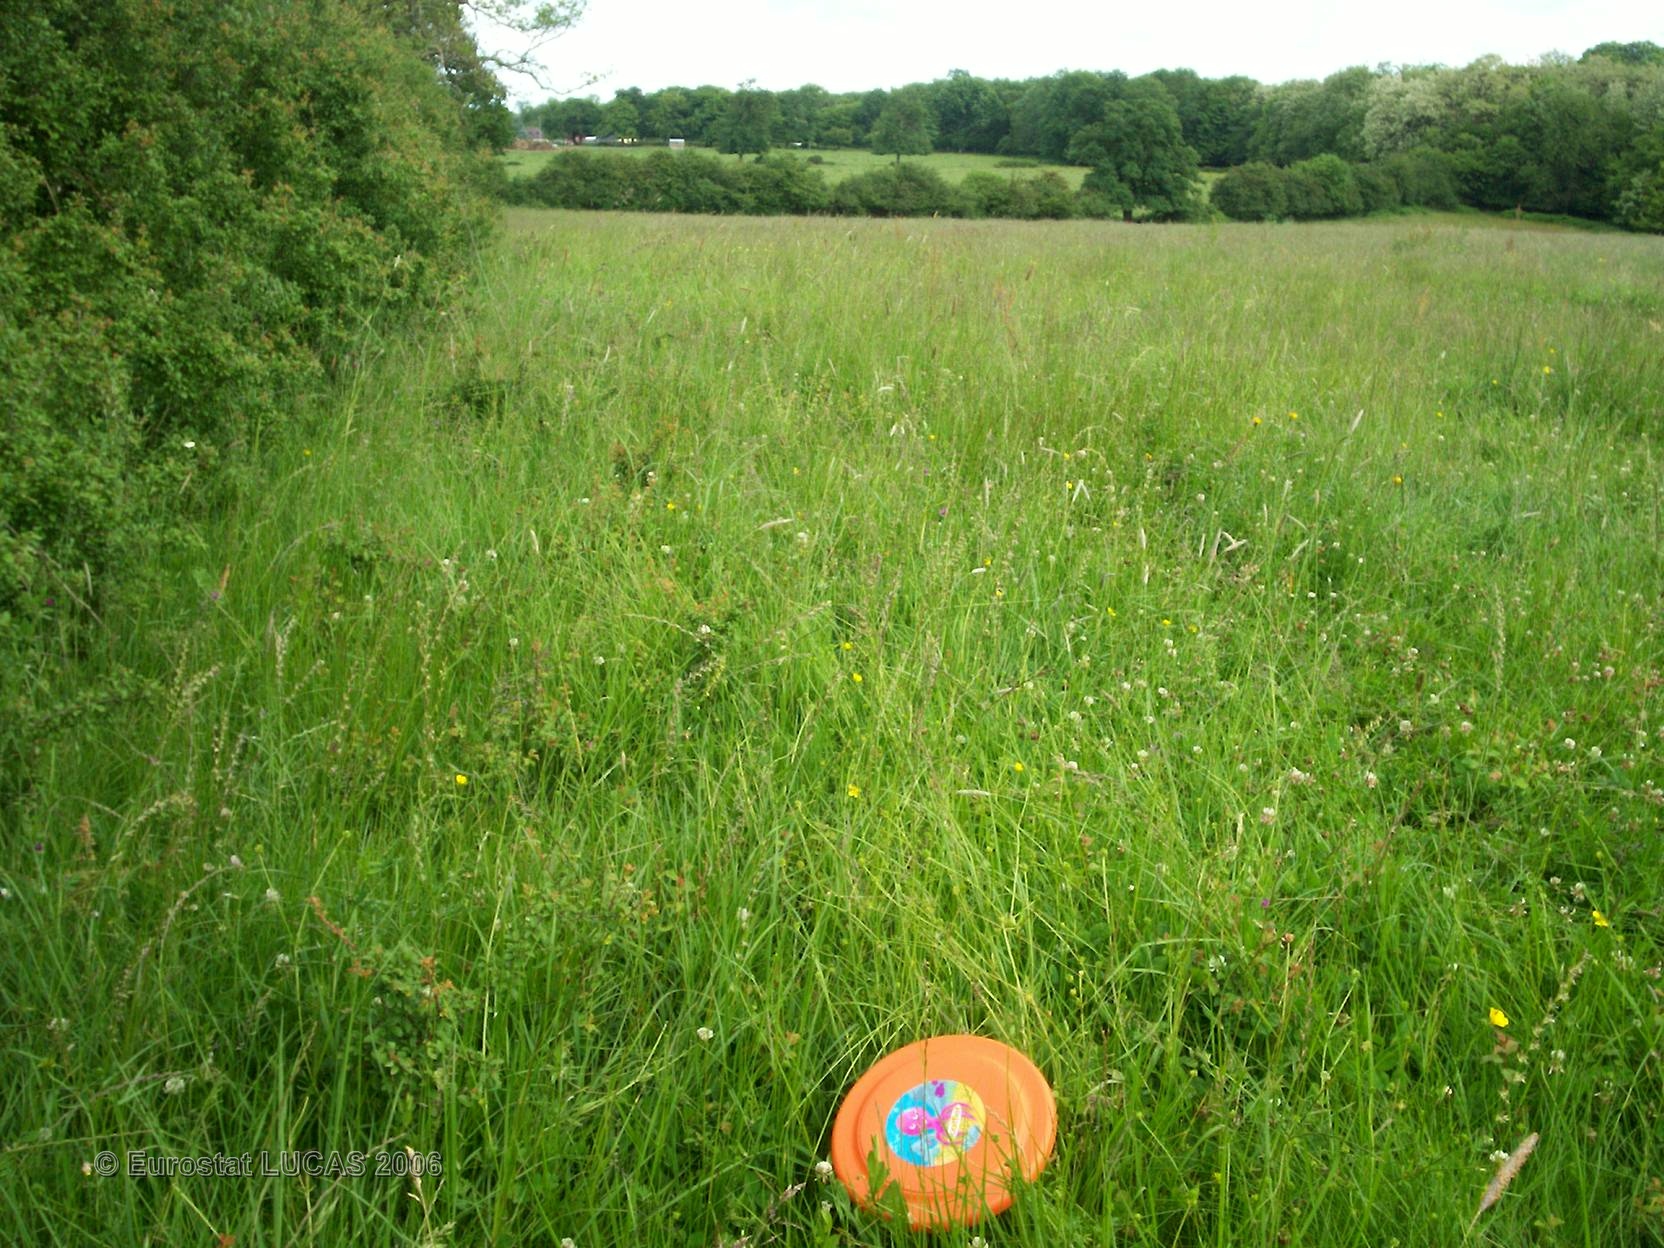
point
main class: Grassland
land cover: Grassland without tree/shrub cover
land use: Agriculture (excluding fallow land and kitchen gardens)
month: June
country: FR
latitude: 47.0439
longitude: 3.0066
